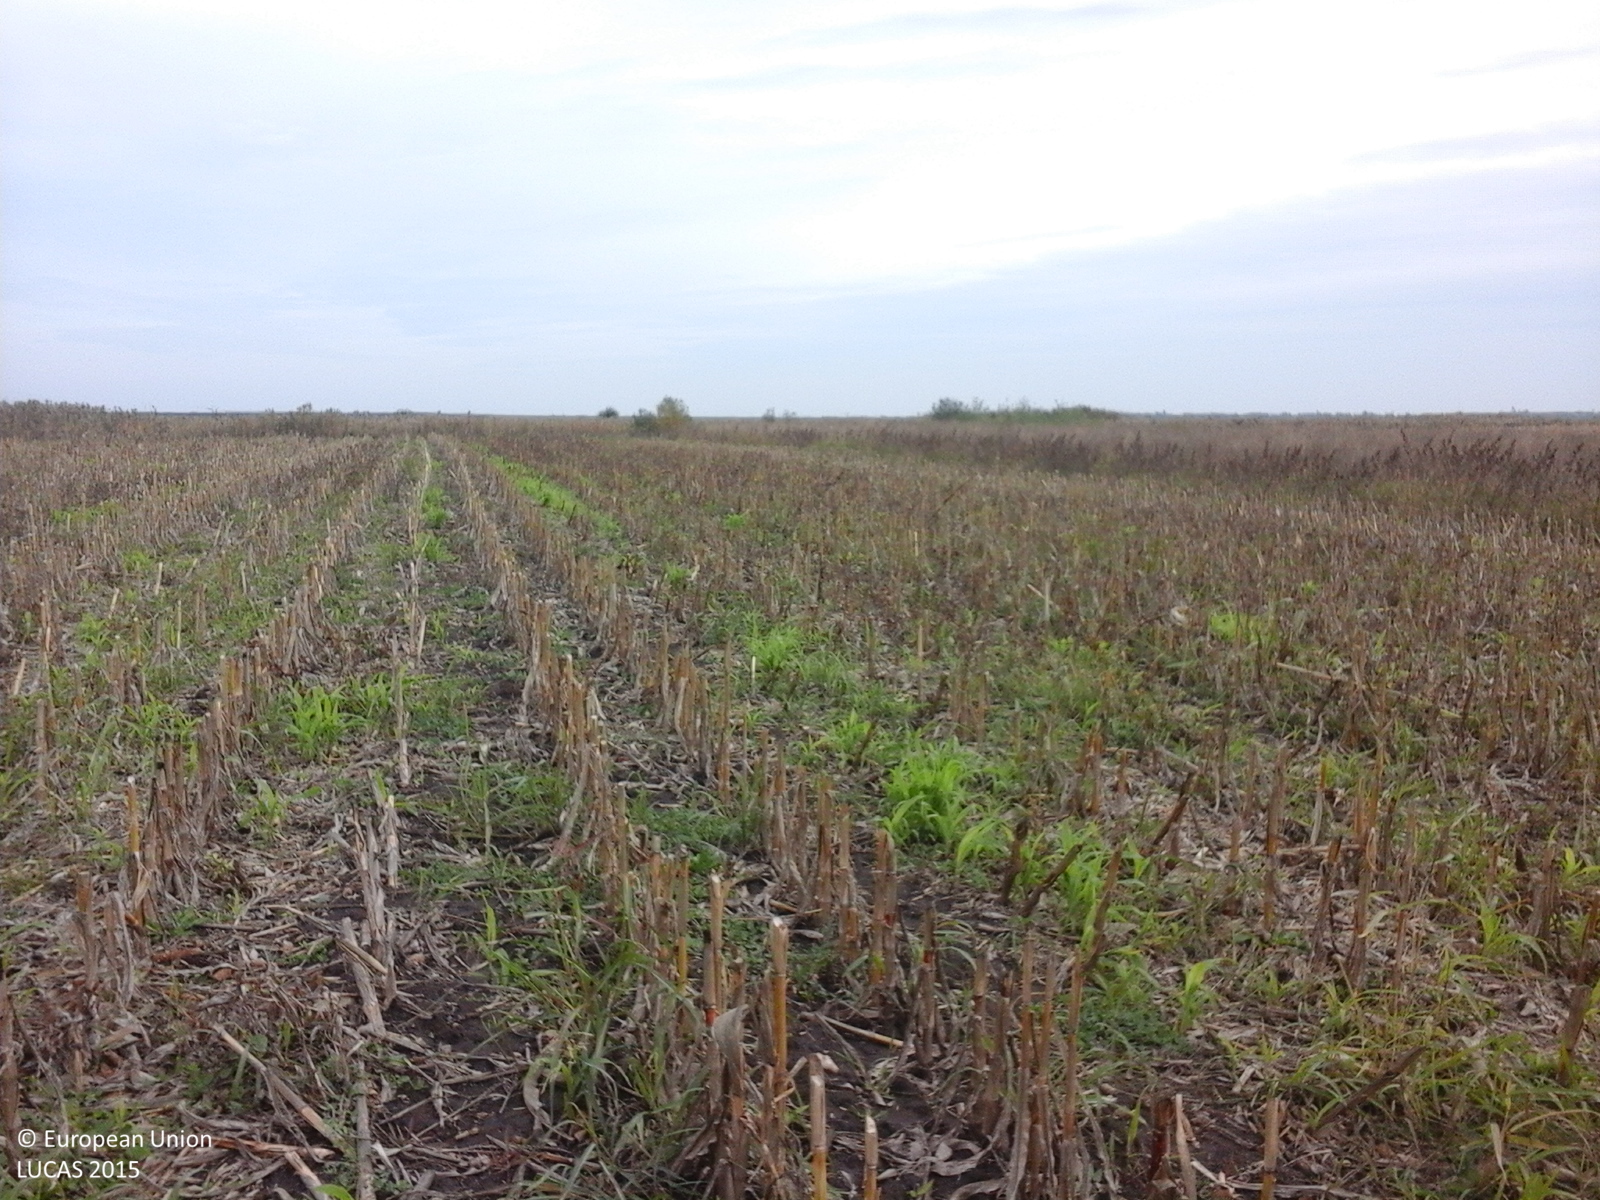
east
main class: Cropland
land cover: Maize
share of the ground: 25 - 50 %
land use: Agriculture (excluding fallow land and kitchen gardens)
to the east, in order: Maize; Spontaneously vegetated surfaces; Inland marshes; Inland fresh water bodies; Inland marshes; Grassland without tree/shrub cover; Ditches and canals; Spontaneously vegetated surfaces
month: October
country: RO
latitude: 44.9219
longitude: 26.3186
